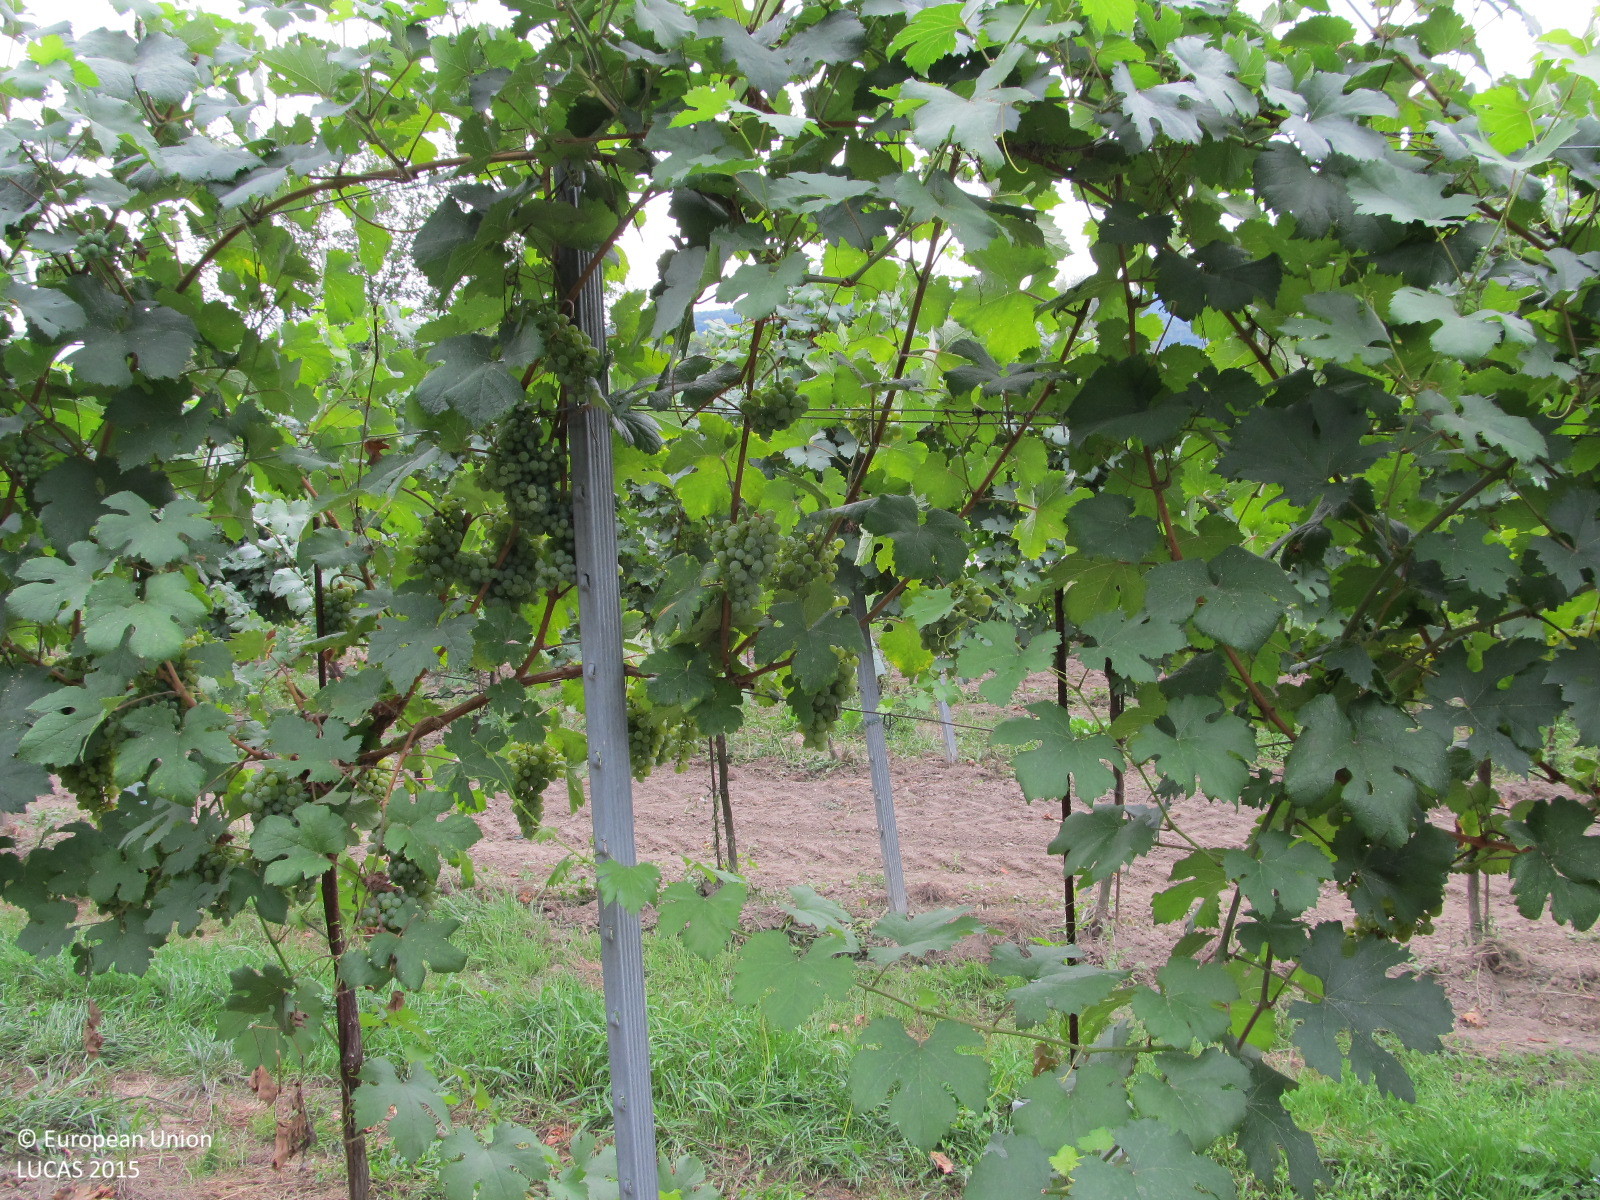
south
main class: Cropland
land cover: Vineyards
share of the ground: 10 - 25 %
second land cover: Other bare soil
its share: > 75 %
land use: Agriculture (excluding fallow land and kitchen gardens)
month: September
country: AT
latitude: 48.4109
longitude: 15.5012
